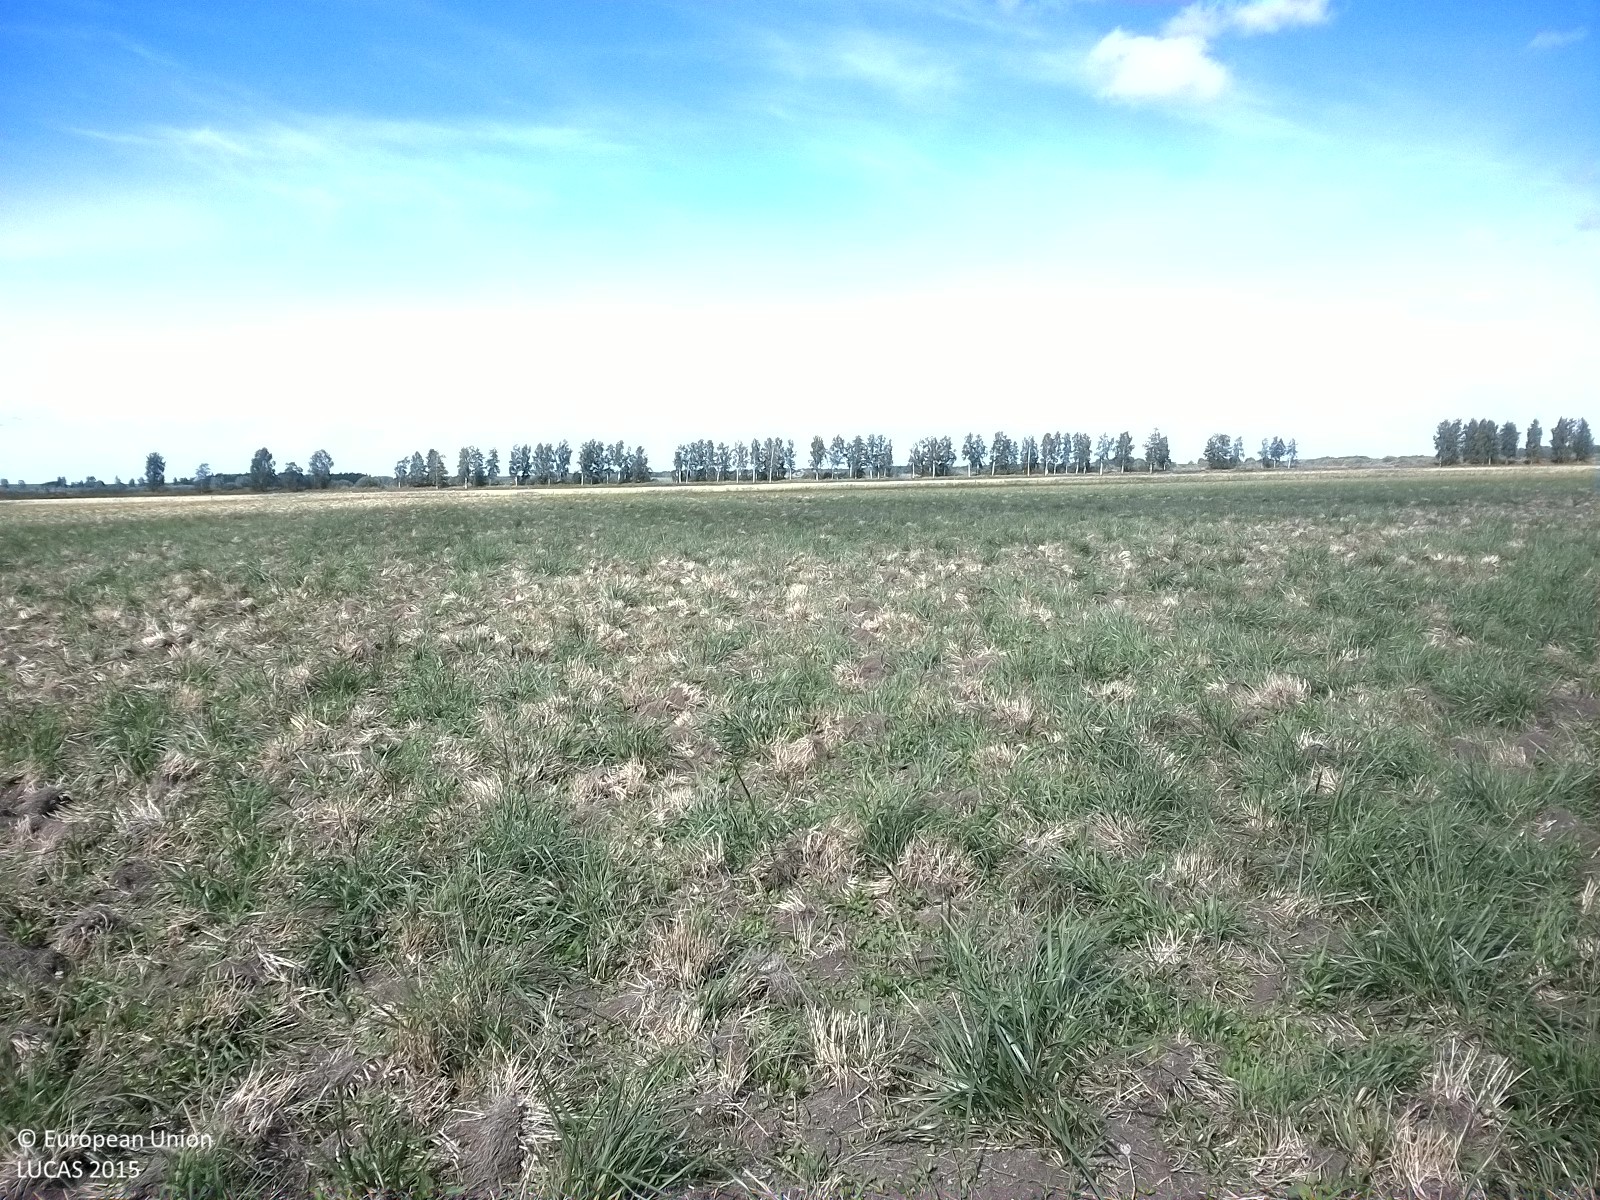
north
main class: Cropland
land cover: Temporary grasslands
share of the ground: > 75 %
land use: Agriculture (excluding fallow land and kitchen gardens)
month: August
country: SE
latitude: 59.1573
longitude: 15.3957
